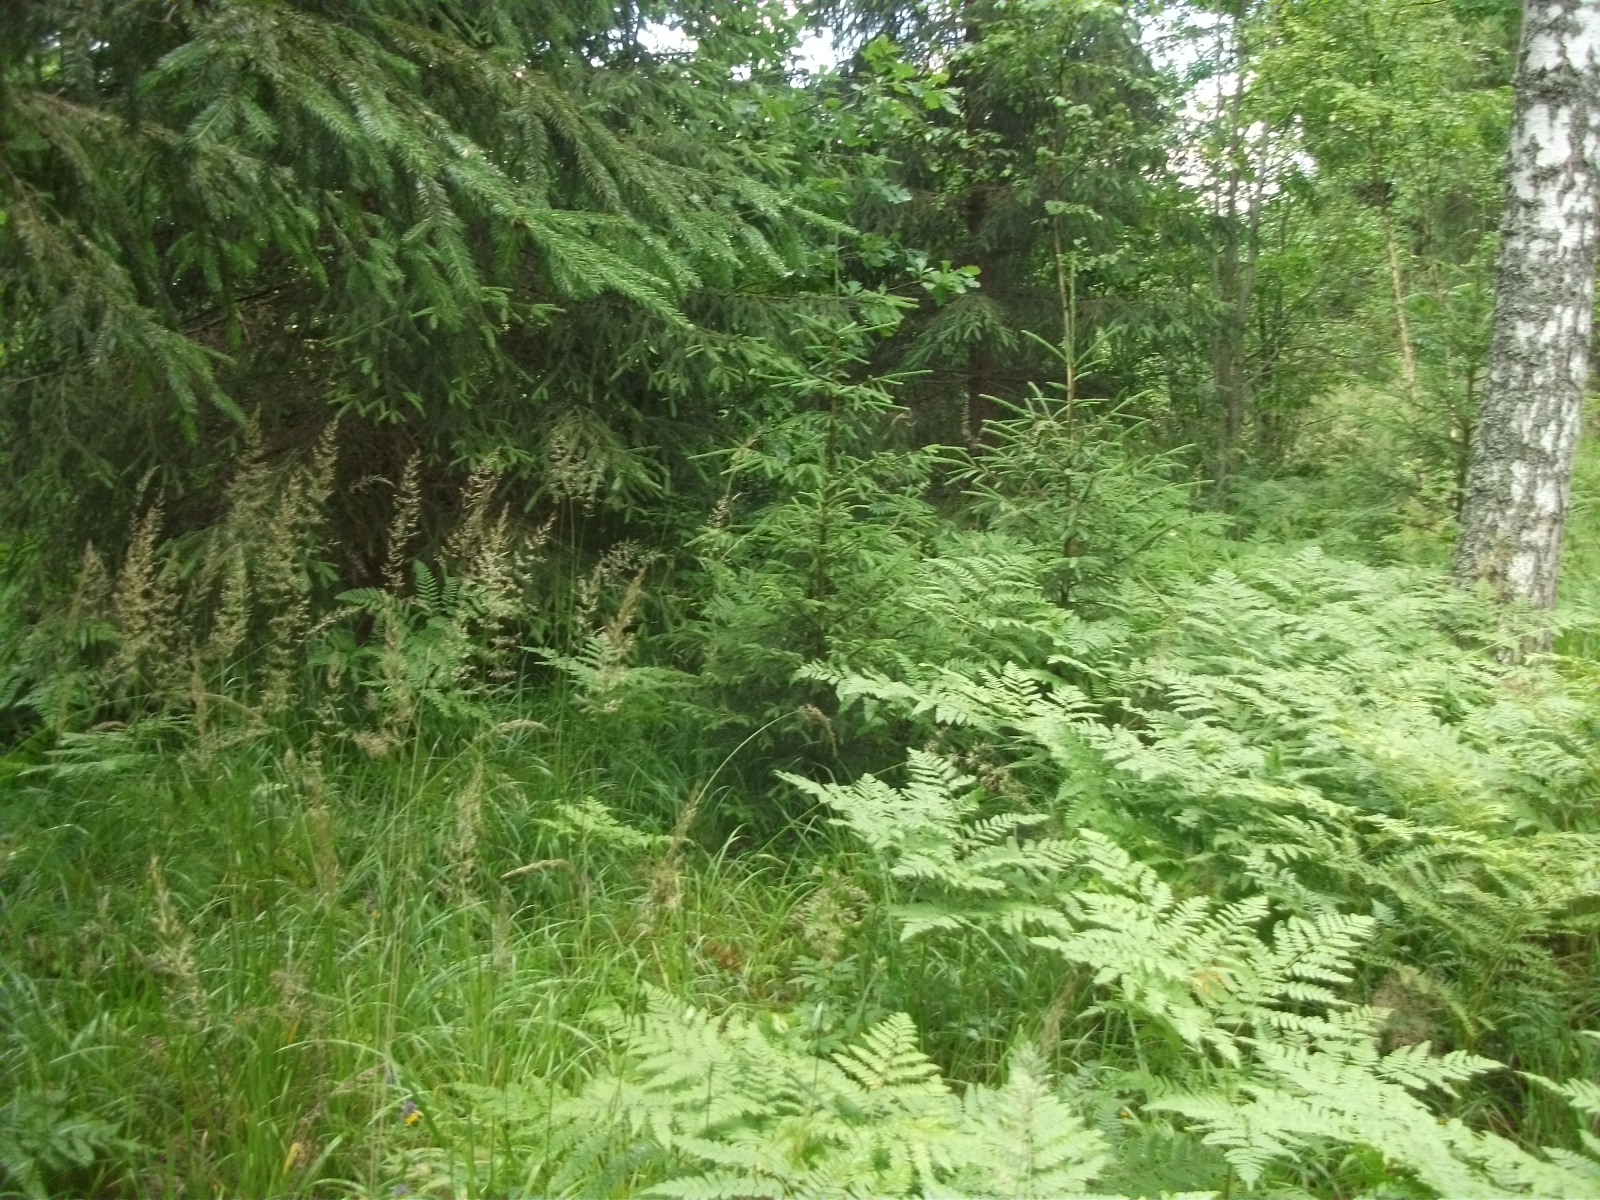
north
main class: Woodland
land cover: Spruce dominated mixed woodland
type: hemiboreal forest and nemoral coniferous forest and mixed broadleaved-coniferous forest
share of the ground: 50 - 75 %
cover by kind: coniferous forest trees 50 %, broadleaved forest trees 20 %, shrubs 15 %, herbaceous plants 15 %
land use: Forestry
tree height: > 5 m
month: July
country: LV
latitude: 56.9205
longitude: 25.8486
